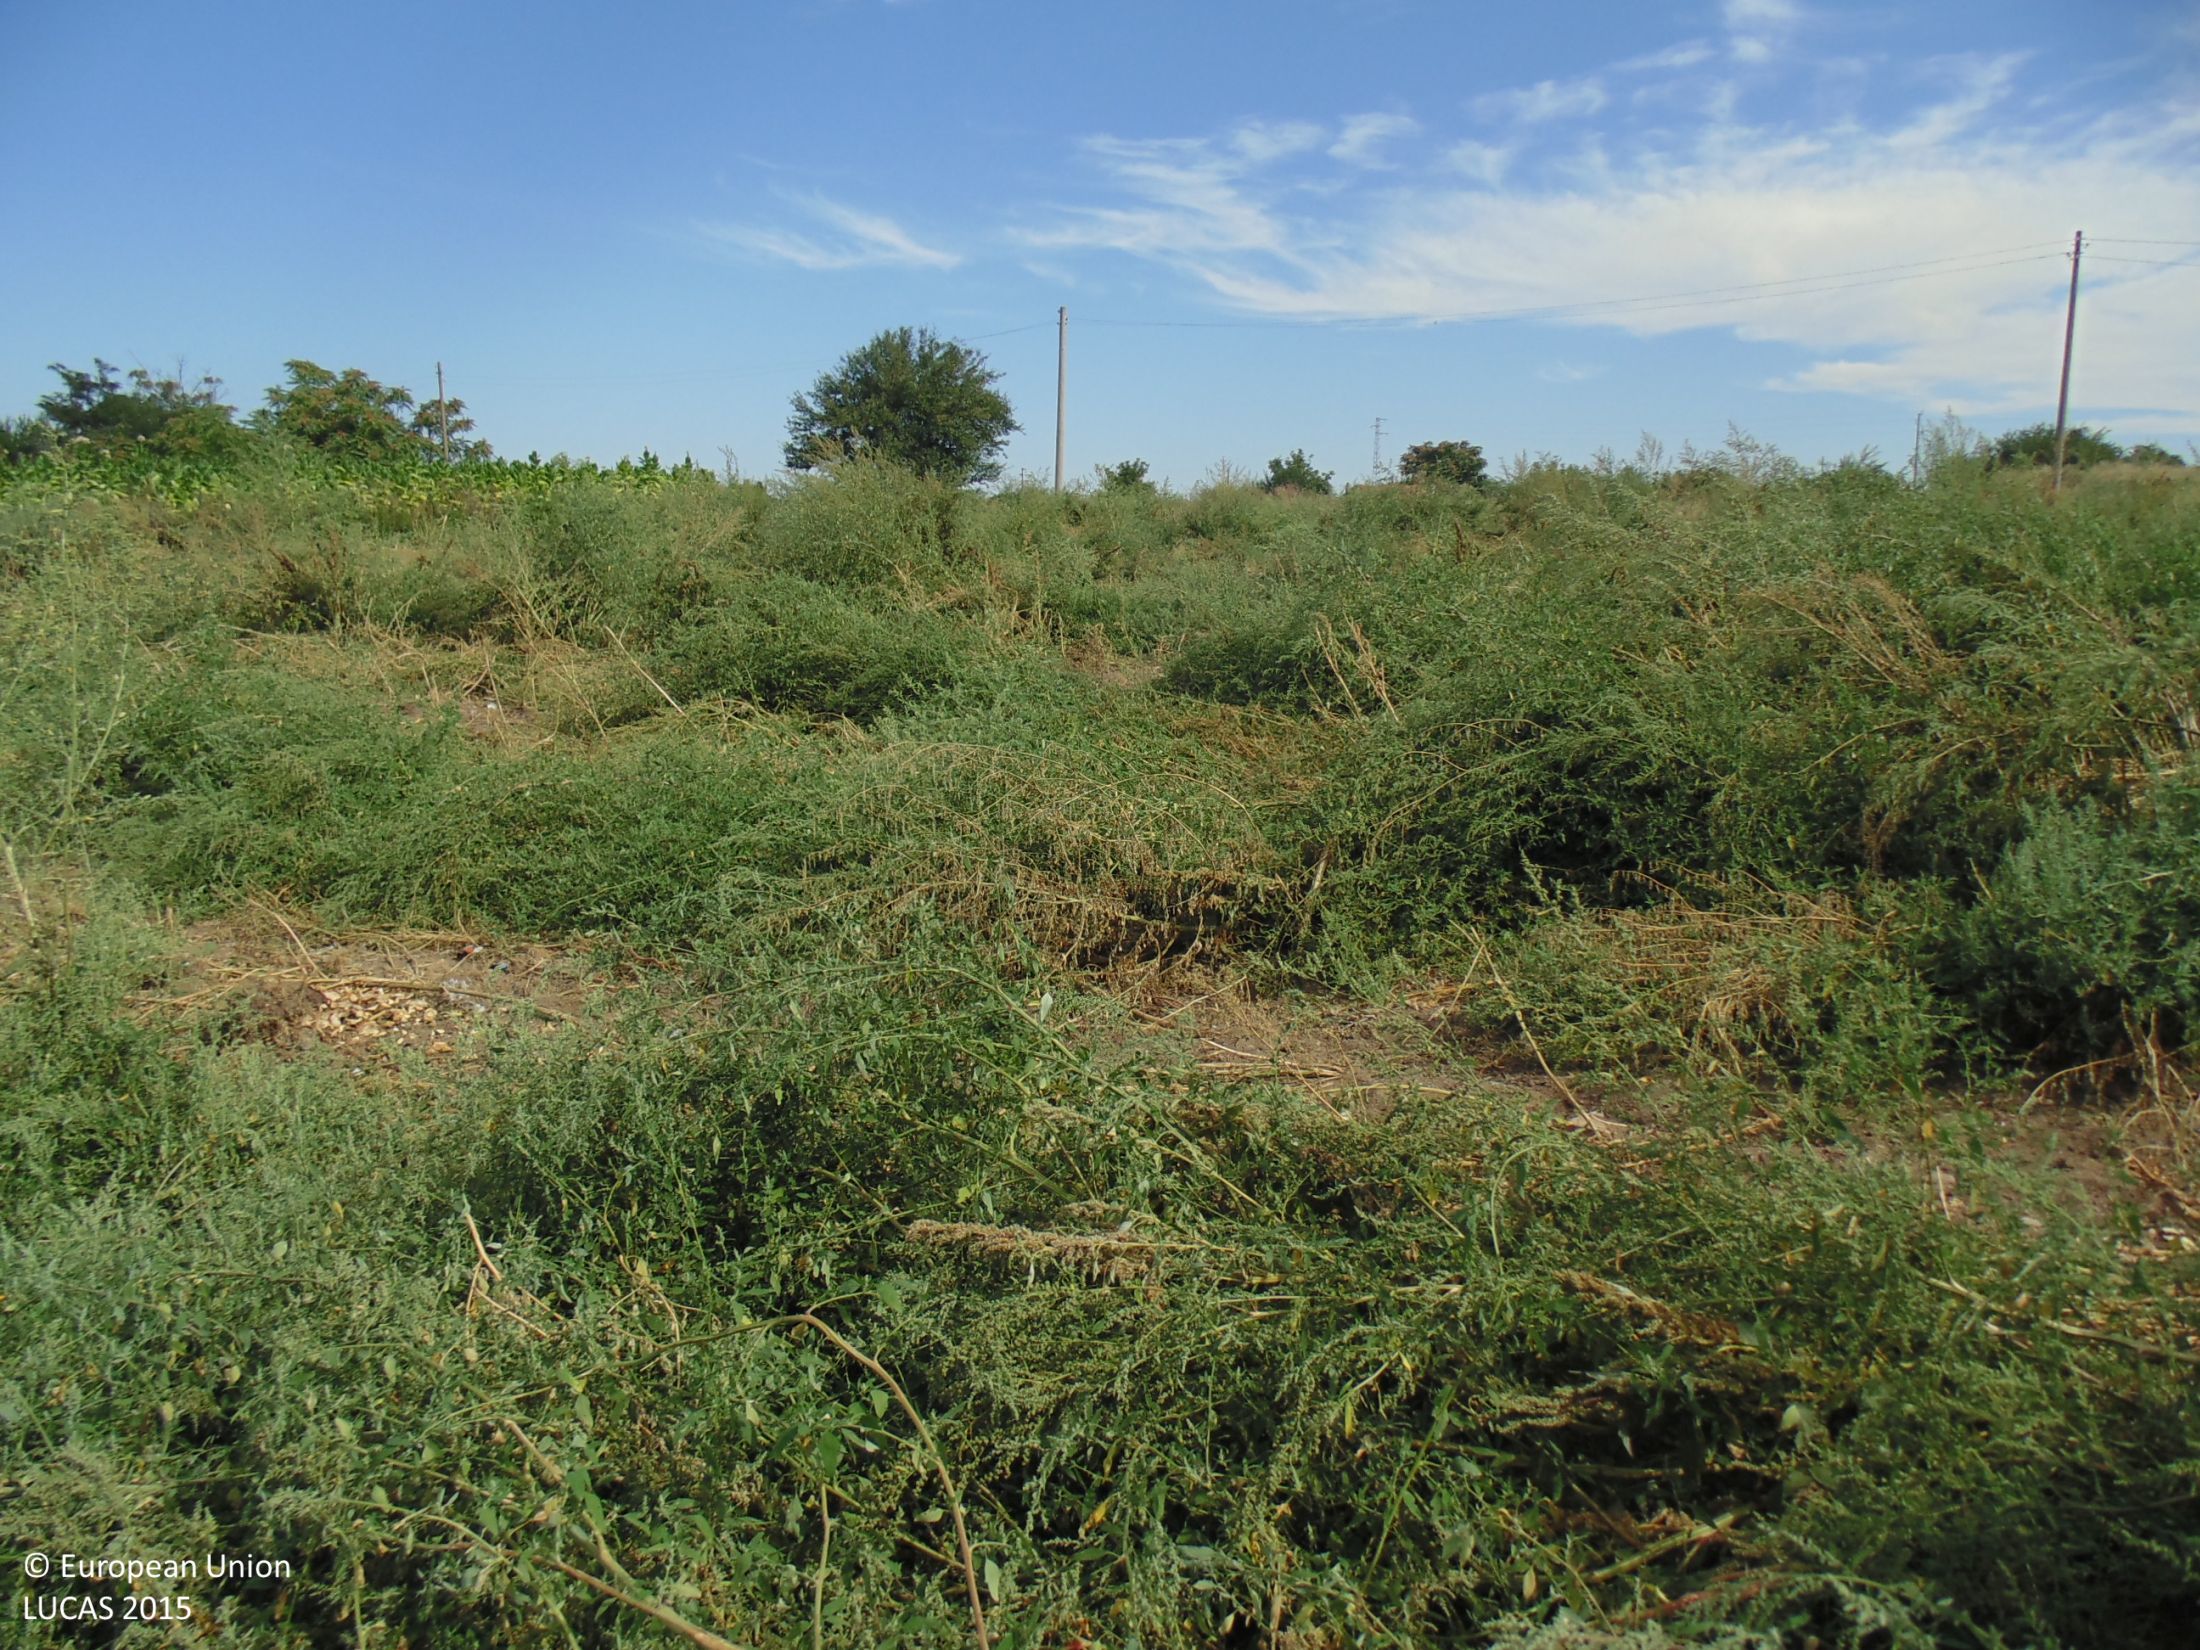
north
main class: Cropland
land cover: Other fresh vegetables
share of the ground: > 75 %
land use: Agriculture (excluding fallow land and kitchen gardens)
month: September
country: BG
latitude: 43.8775
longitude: 27.0872
